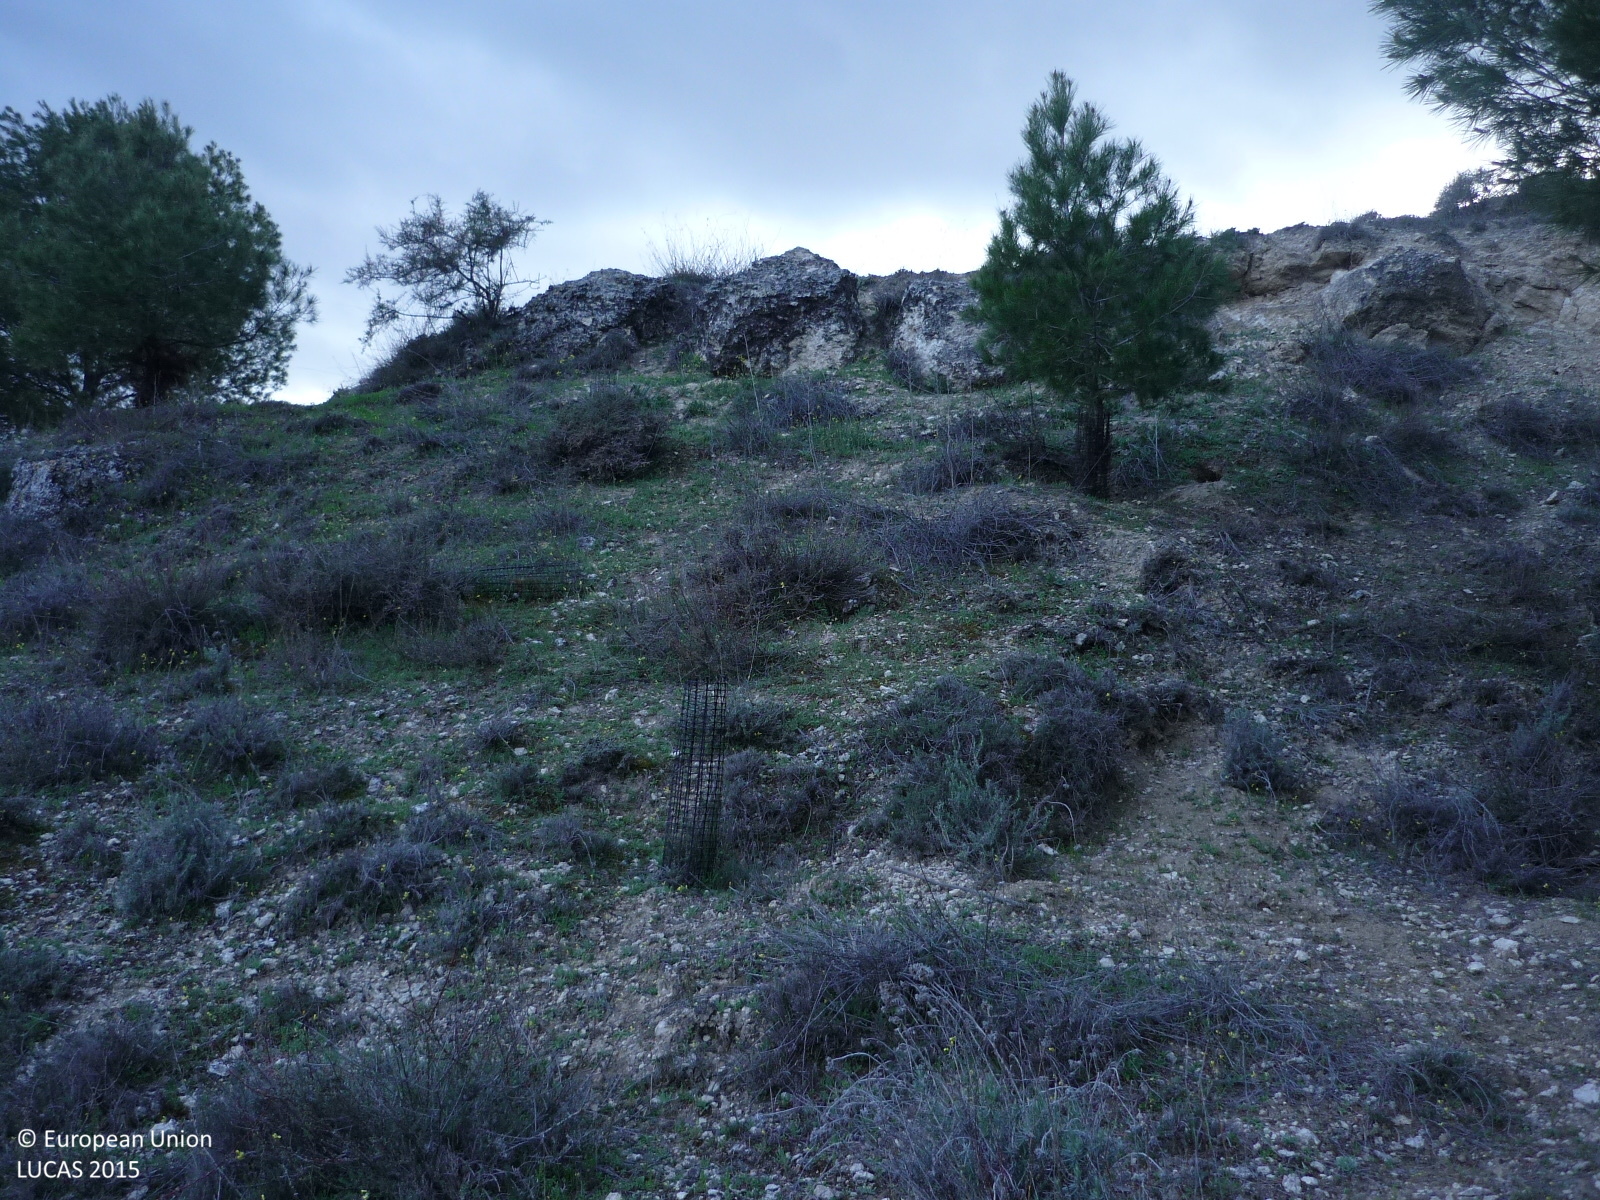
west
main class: Woodland
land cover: Pine dominated coniferous woodland
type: coniferous forest of the mediterranean region
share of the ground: 10 - 25 %
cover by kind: herbaceous plants 45 %, coniferous forest trees 20 %, consolidated bare surface 20 %, shrubs 15 %
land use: Semi-natural and natural areas not in use
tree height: < 5 m
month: March
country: ES
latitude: 40.4805
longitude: -3.5192
